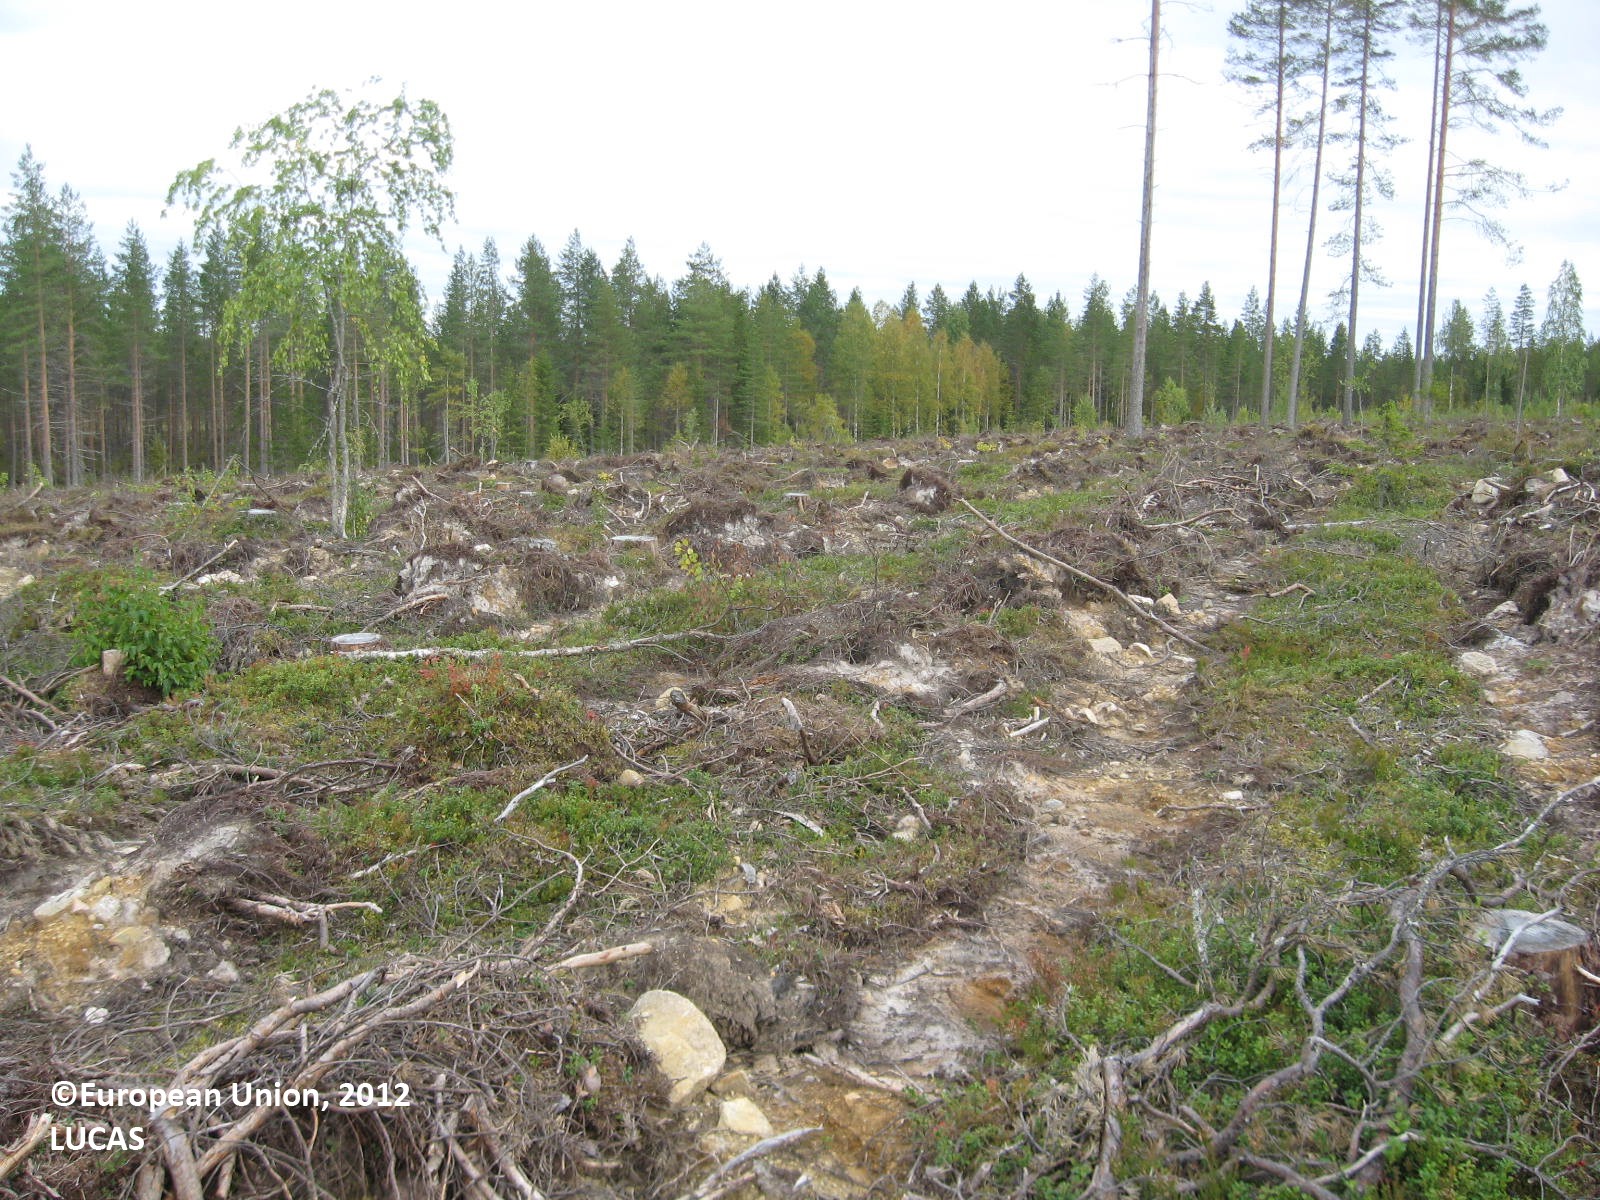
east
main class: Grassland
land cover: Grassland without tree/shrub cover
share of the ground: > 75 %
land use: Forestry
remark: Clear cut
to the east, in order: Grassland without tree/shrub cover; Spruce dominated coniferous woodland; Ditches and canals; Pine dominated coniferous woodland; Ditches and canals; Pine dominated coniferous woodland; Ditches and canals; Pine dominated coniferous woodland
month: August
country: FI
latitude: 63.9707
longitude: 29.2252
